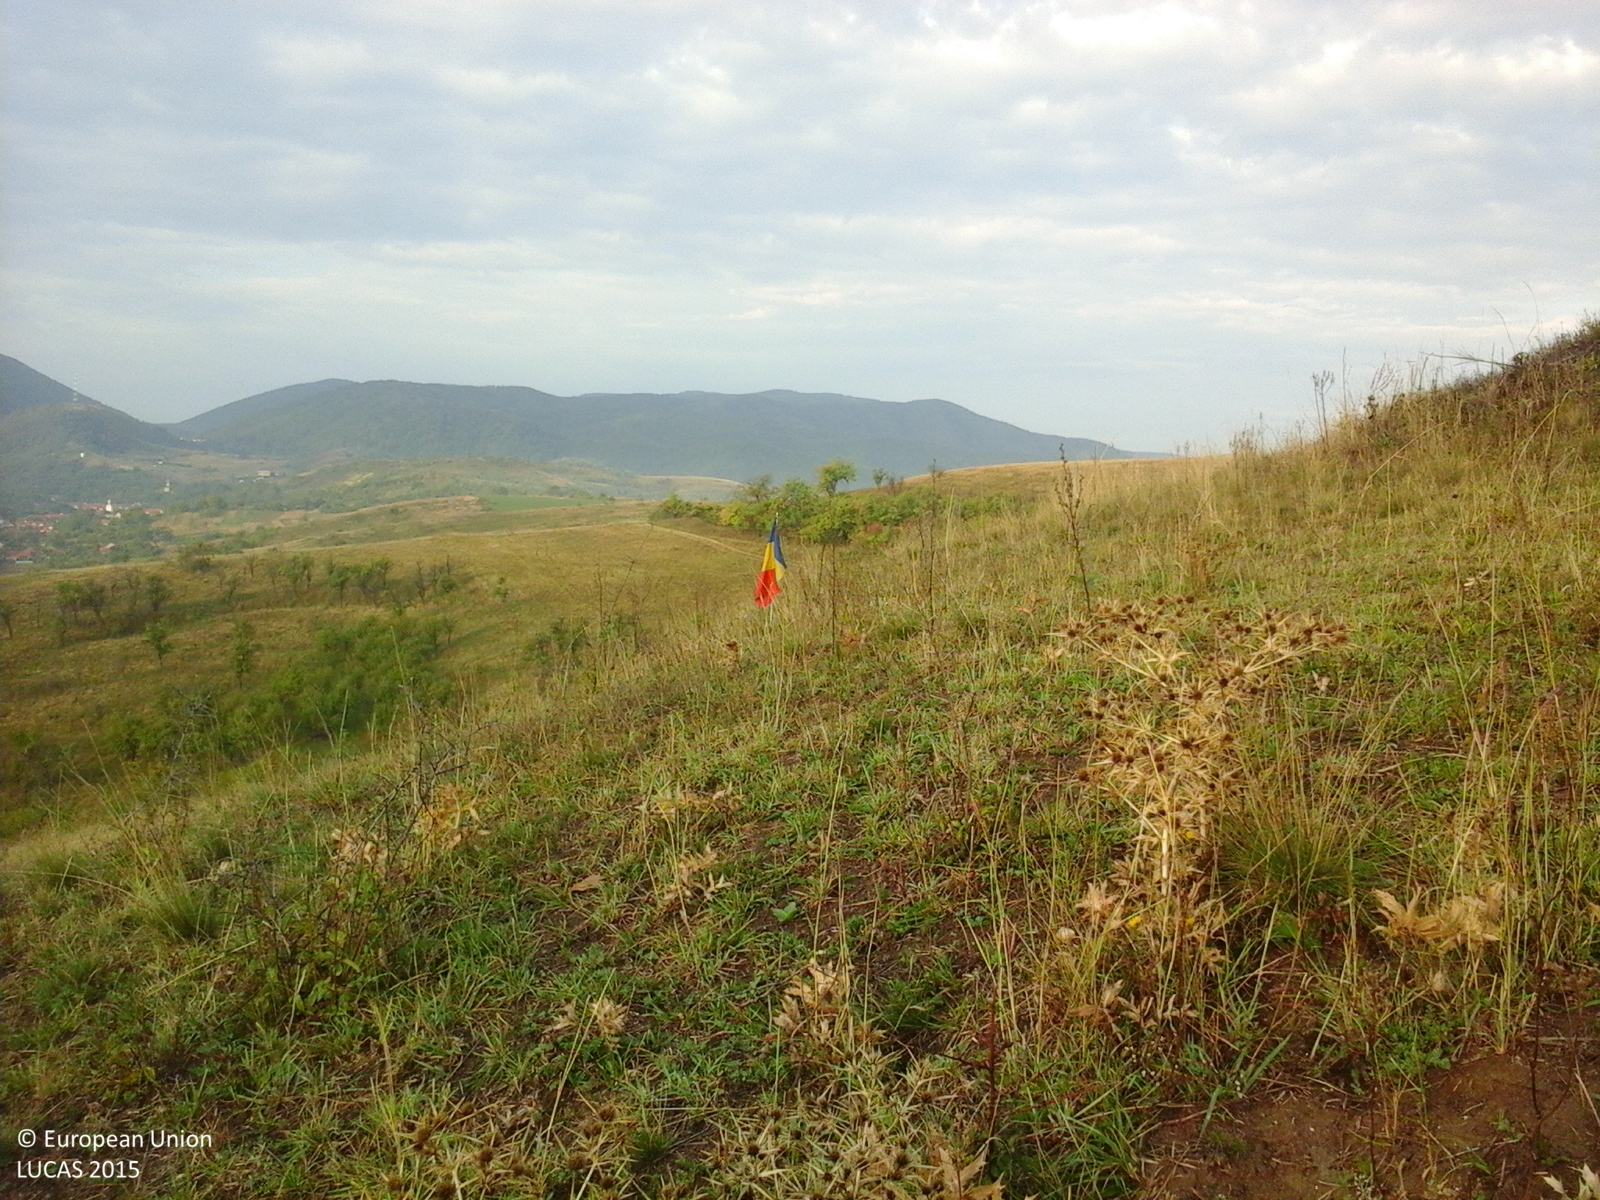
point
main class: Grassland
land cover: Grassland without tree/shrub cover
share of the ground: > 75 %
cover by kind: herbaceous plants 100 %
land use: Agriculture (excluding fallow land and kitchen gardens)
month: September
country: RO
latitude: 45.6576
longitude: 22.8987
